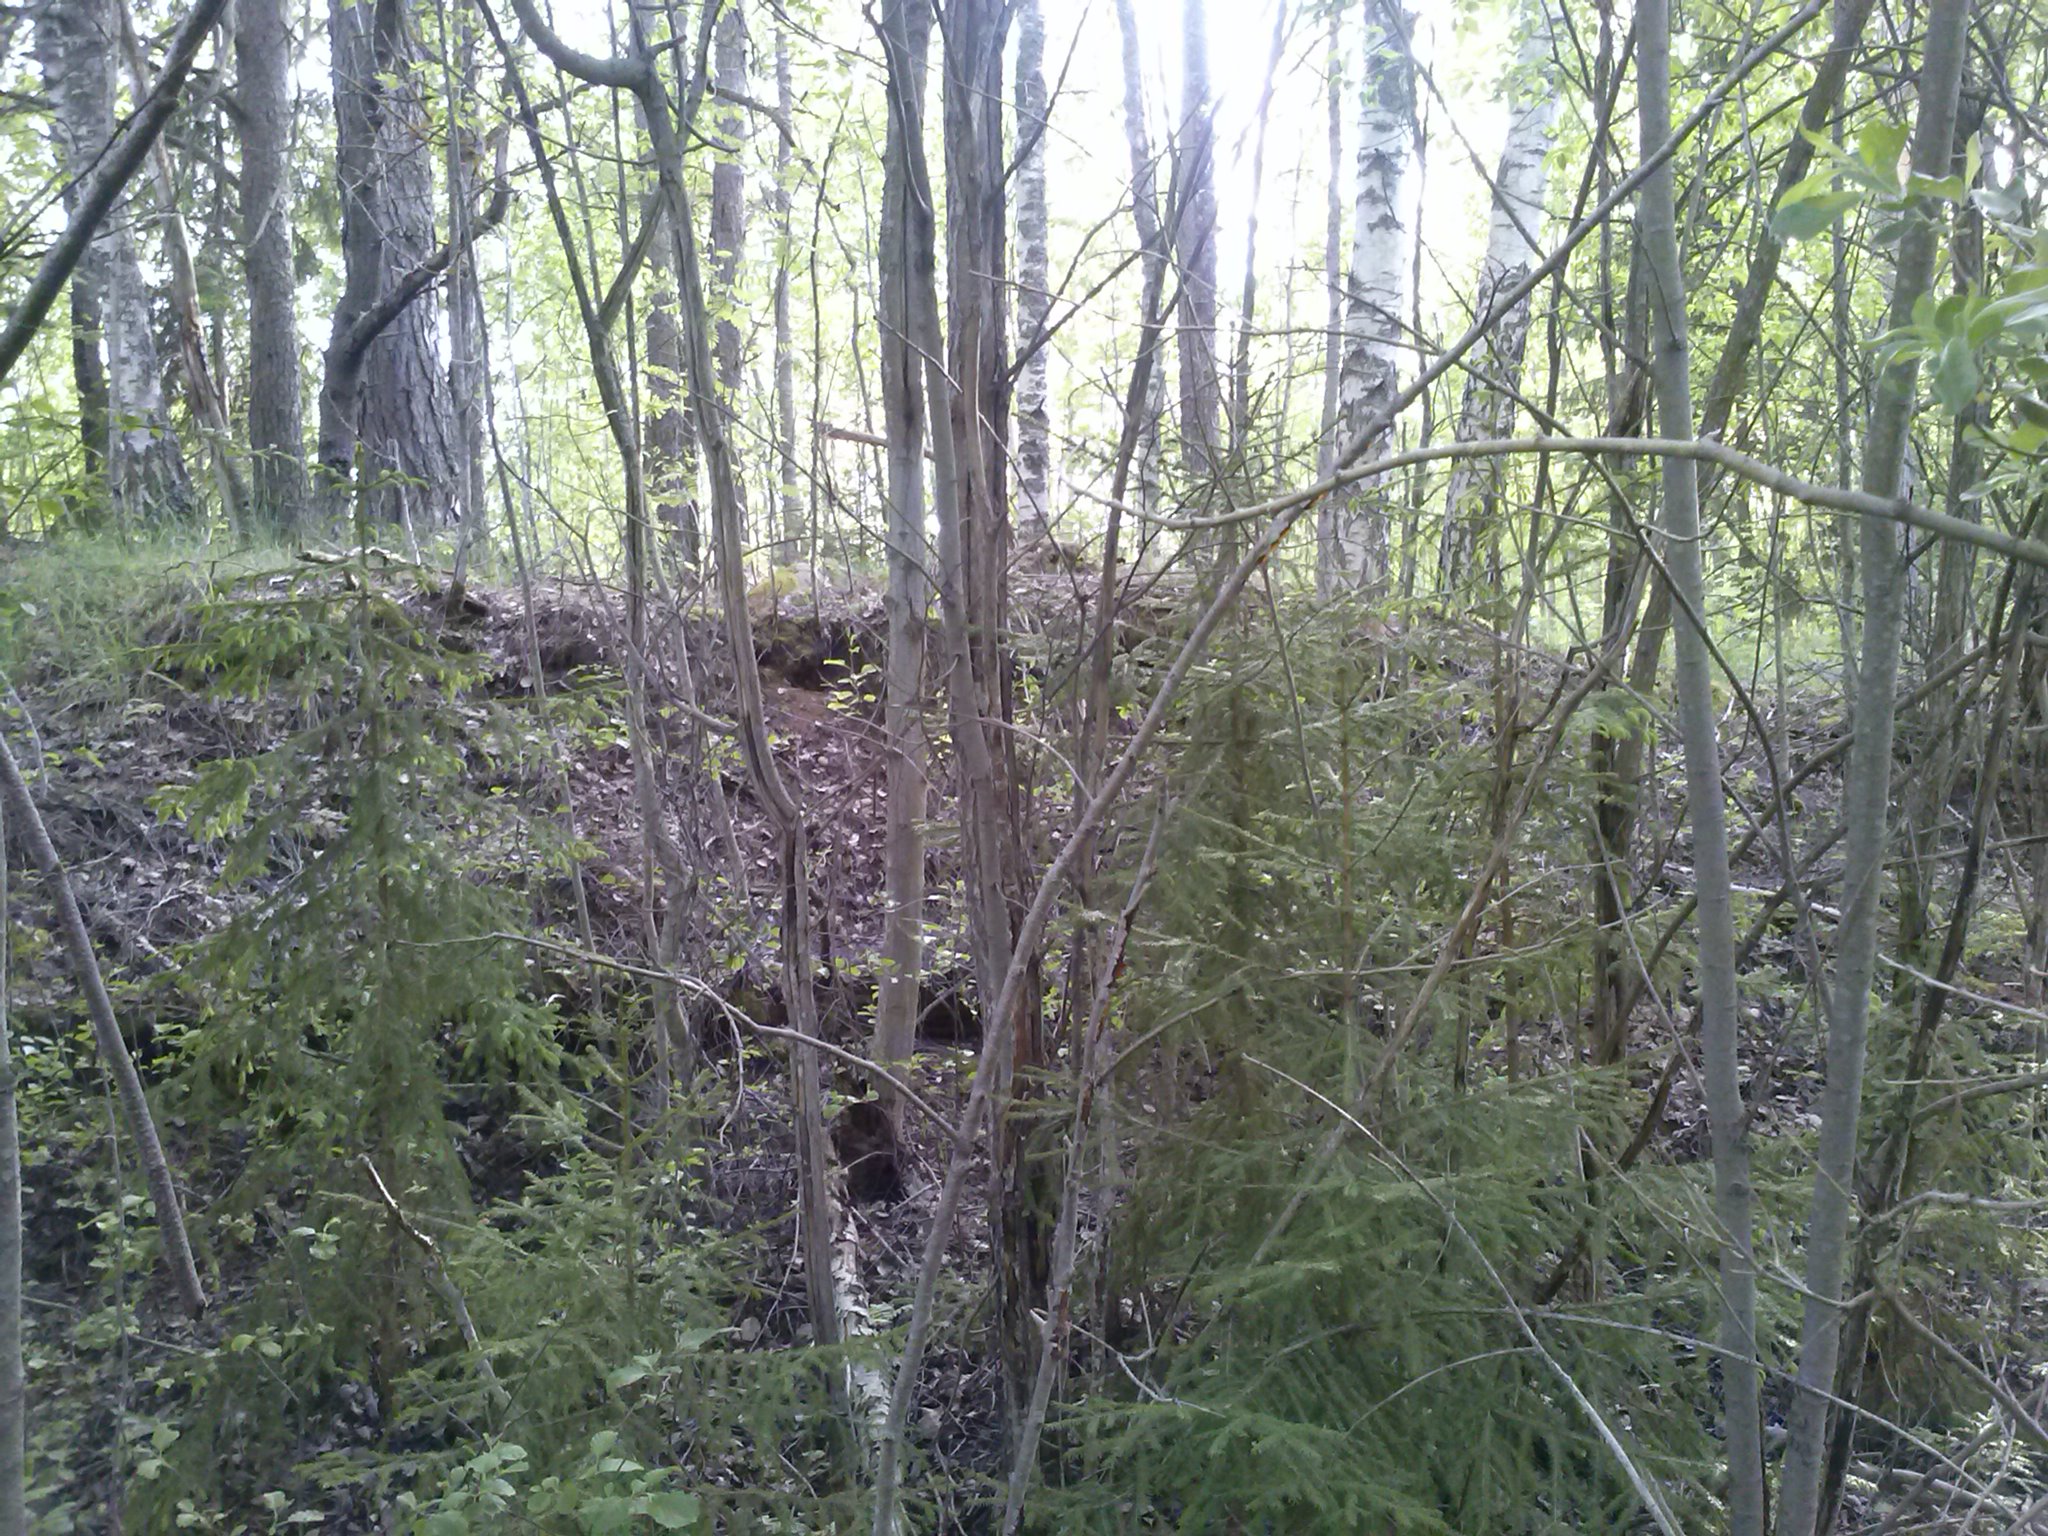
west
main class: Woodland
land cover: Broadleaved woodland
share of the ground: > 75 %
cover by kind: broadleaved forest trees 100 %
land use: Forestry
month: May
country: LV
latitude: 56.3137
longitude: 27.7950
